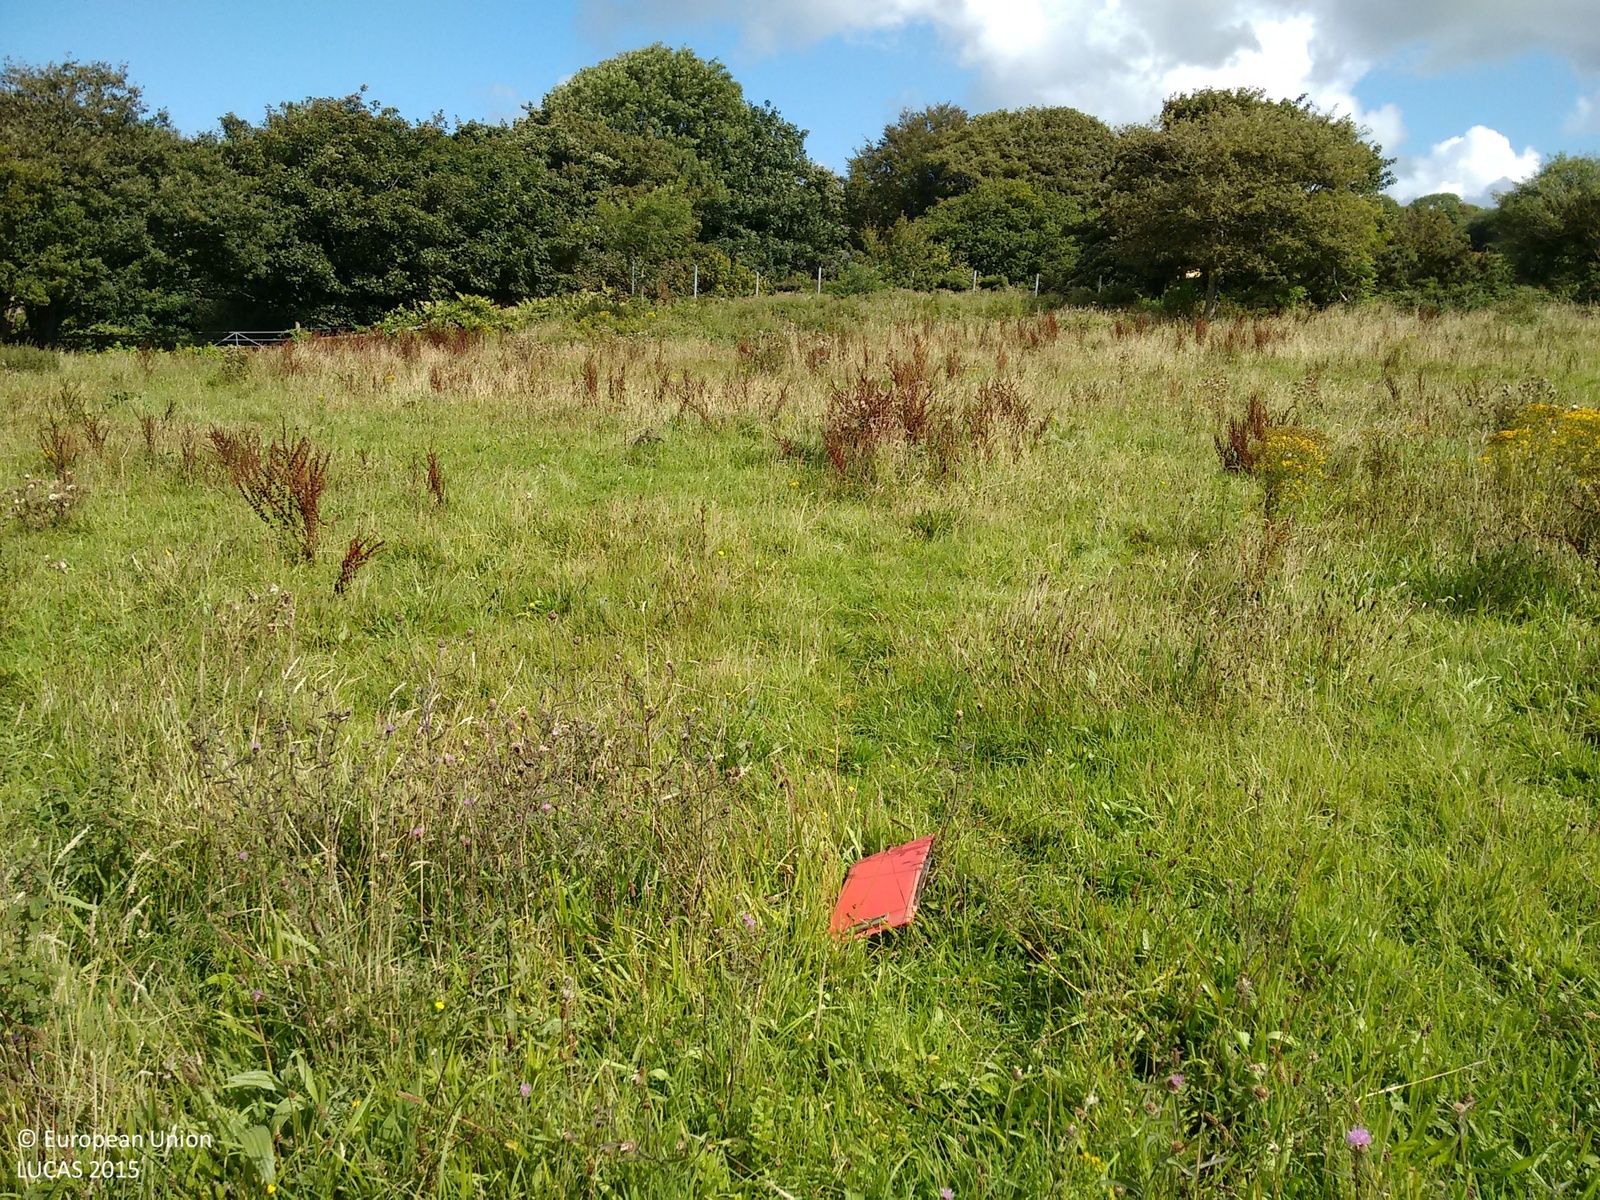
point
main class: Grassland
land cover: Grassland without tree/shrub cover
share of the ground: > 75 %
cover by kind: herbaceous plants 100 %
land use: Agriculture (excluding fallow land and kitchen gardens)
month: August
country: GB
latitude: 50.1882
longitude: -5.2910
